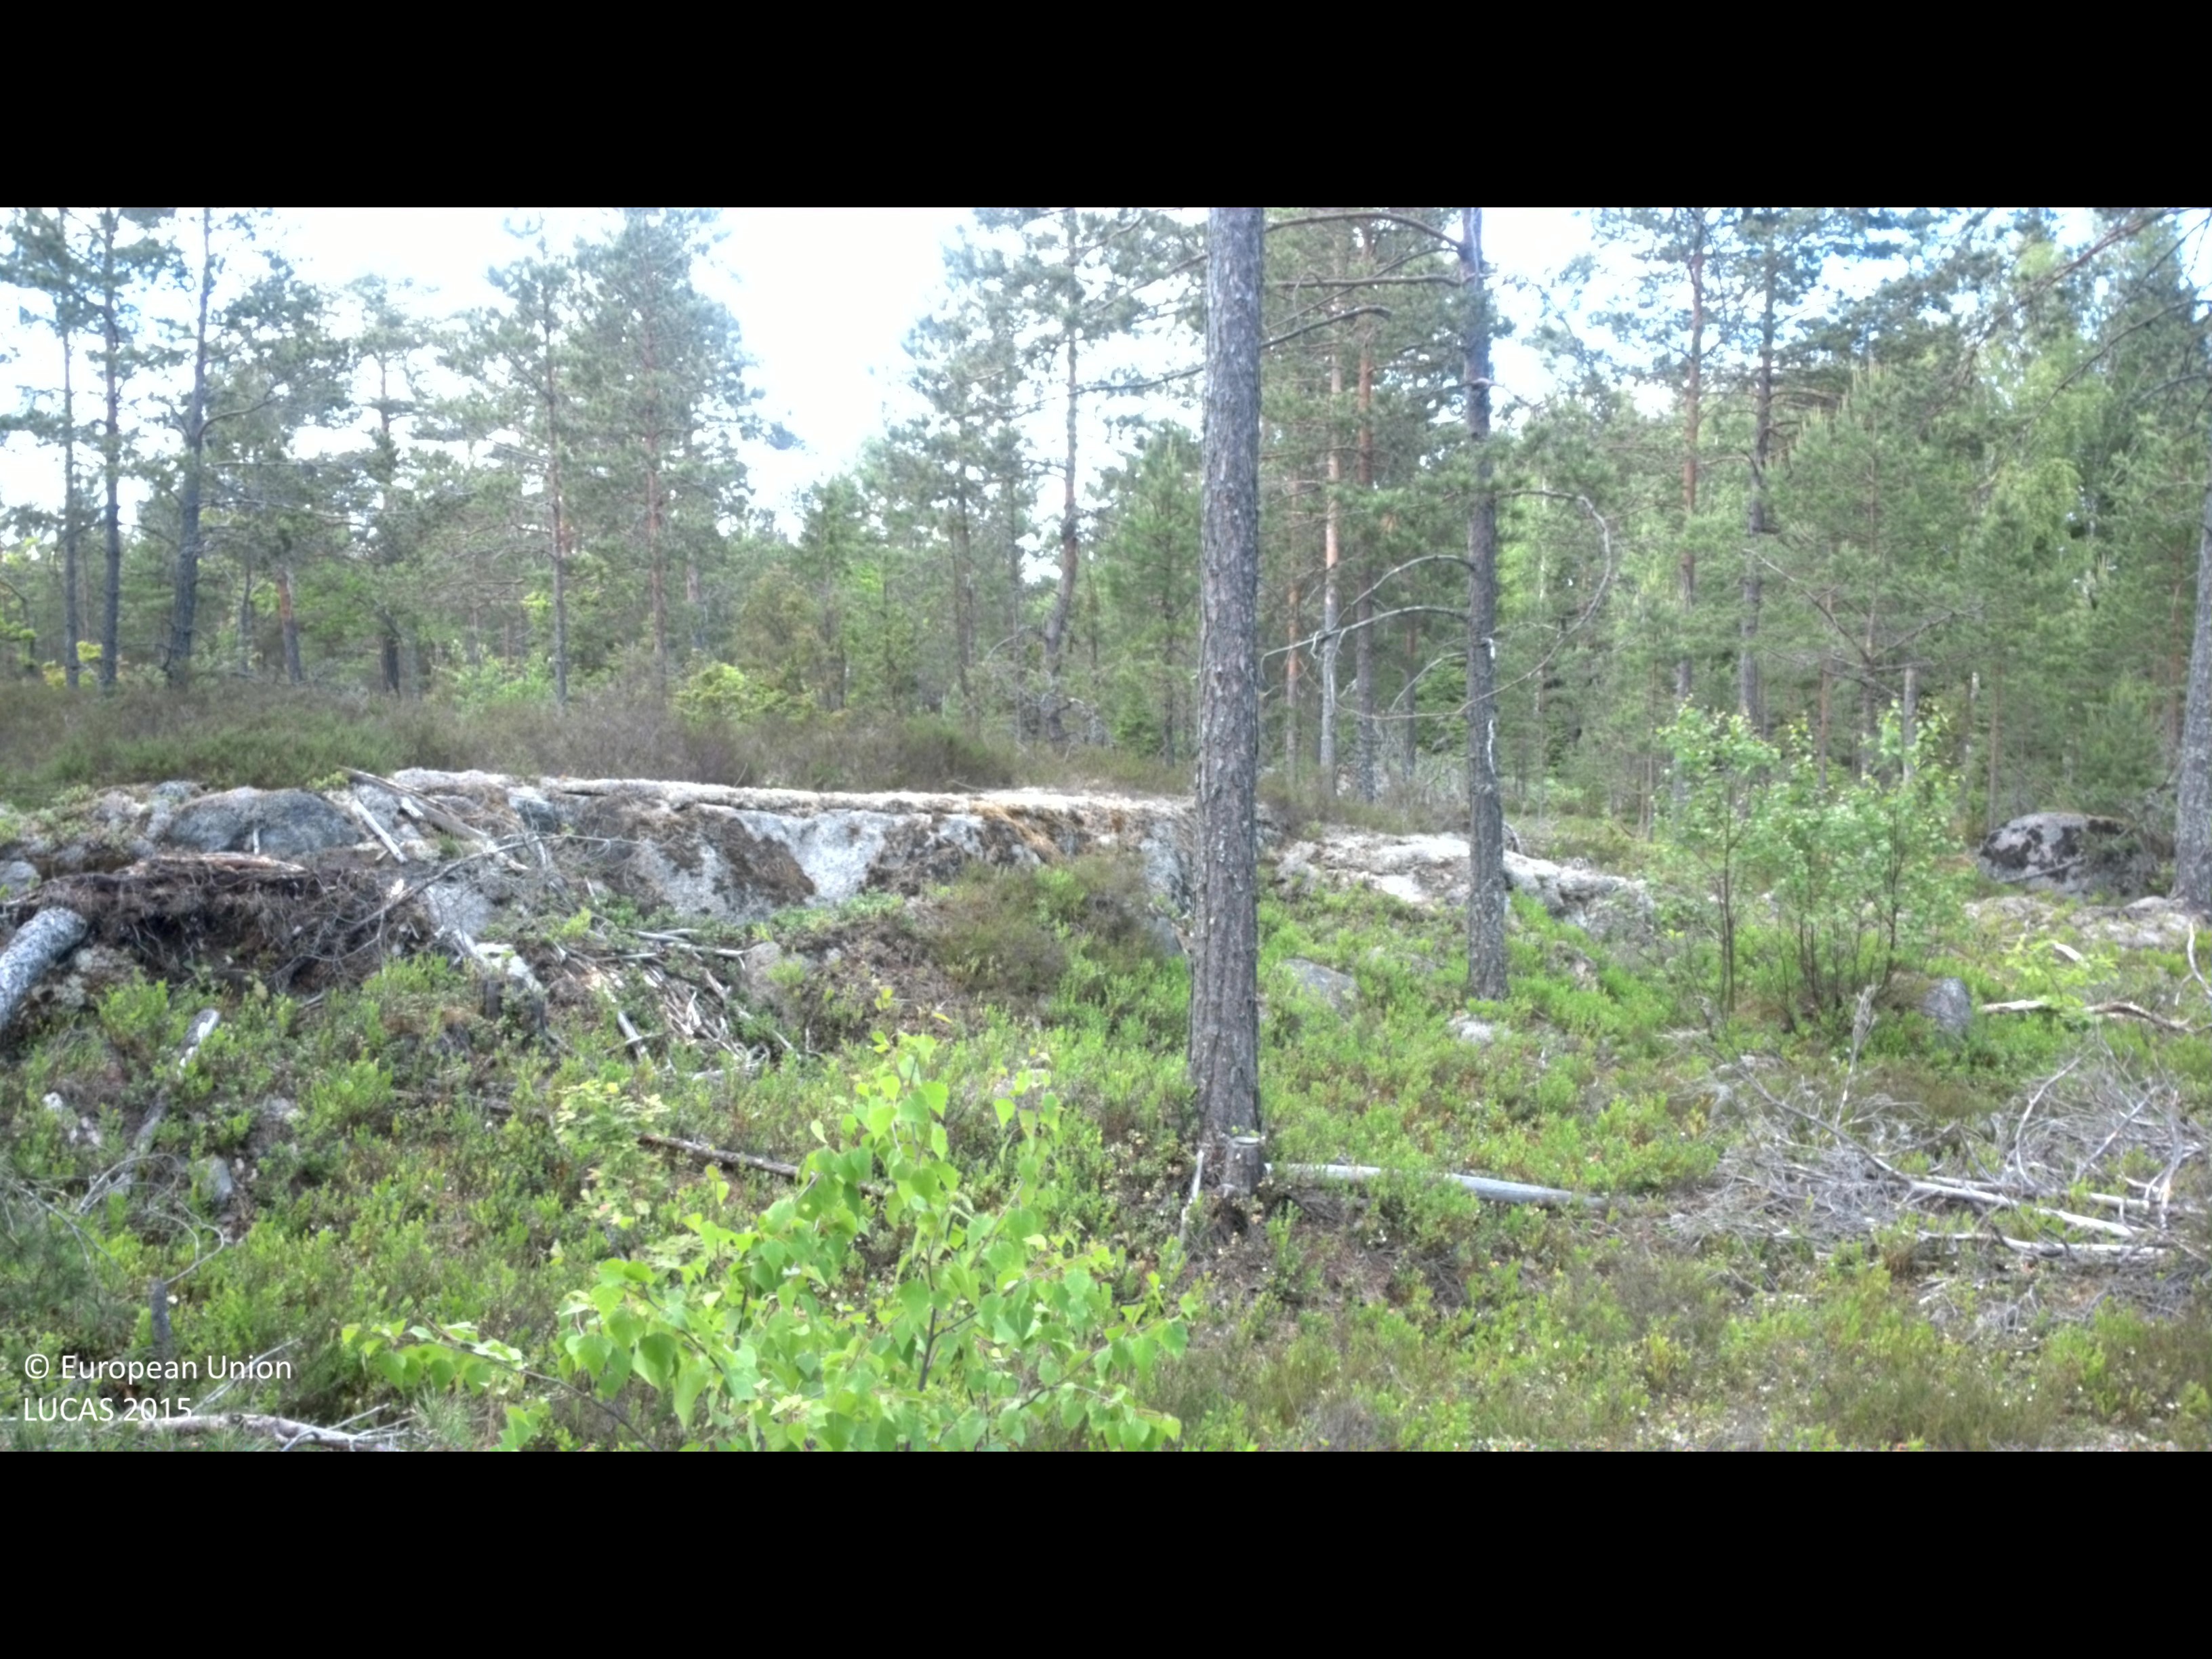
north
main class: Woodland
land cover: Pine dominated coniferous woodland
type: boreal forest
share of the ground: 25 - 50 %
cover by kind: coniferous forest trees 40 %, shrubs 40 %, lichens and mosses 10 %, broadleaved forest trees 5 %, herbaceous plants 5 %
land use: Forestry
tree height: > 5 m
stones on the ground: < 10 %
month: June
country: SE
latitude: 57.6788
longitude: 16.5893
